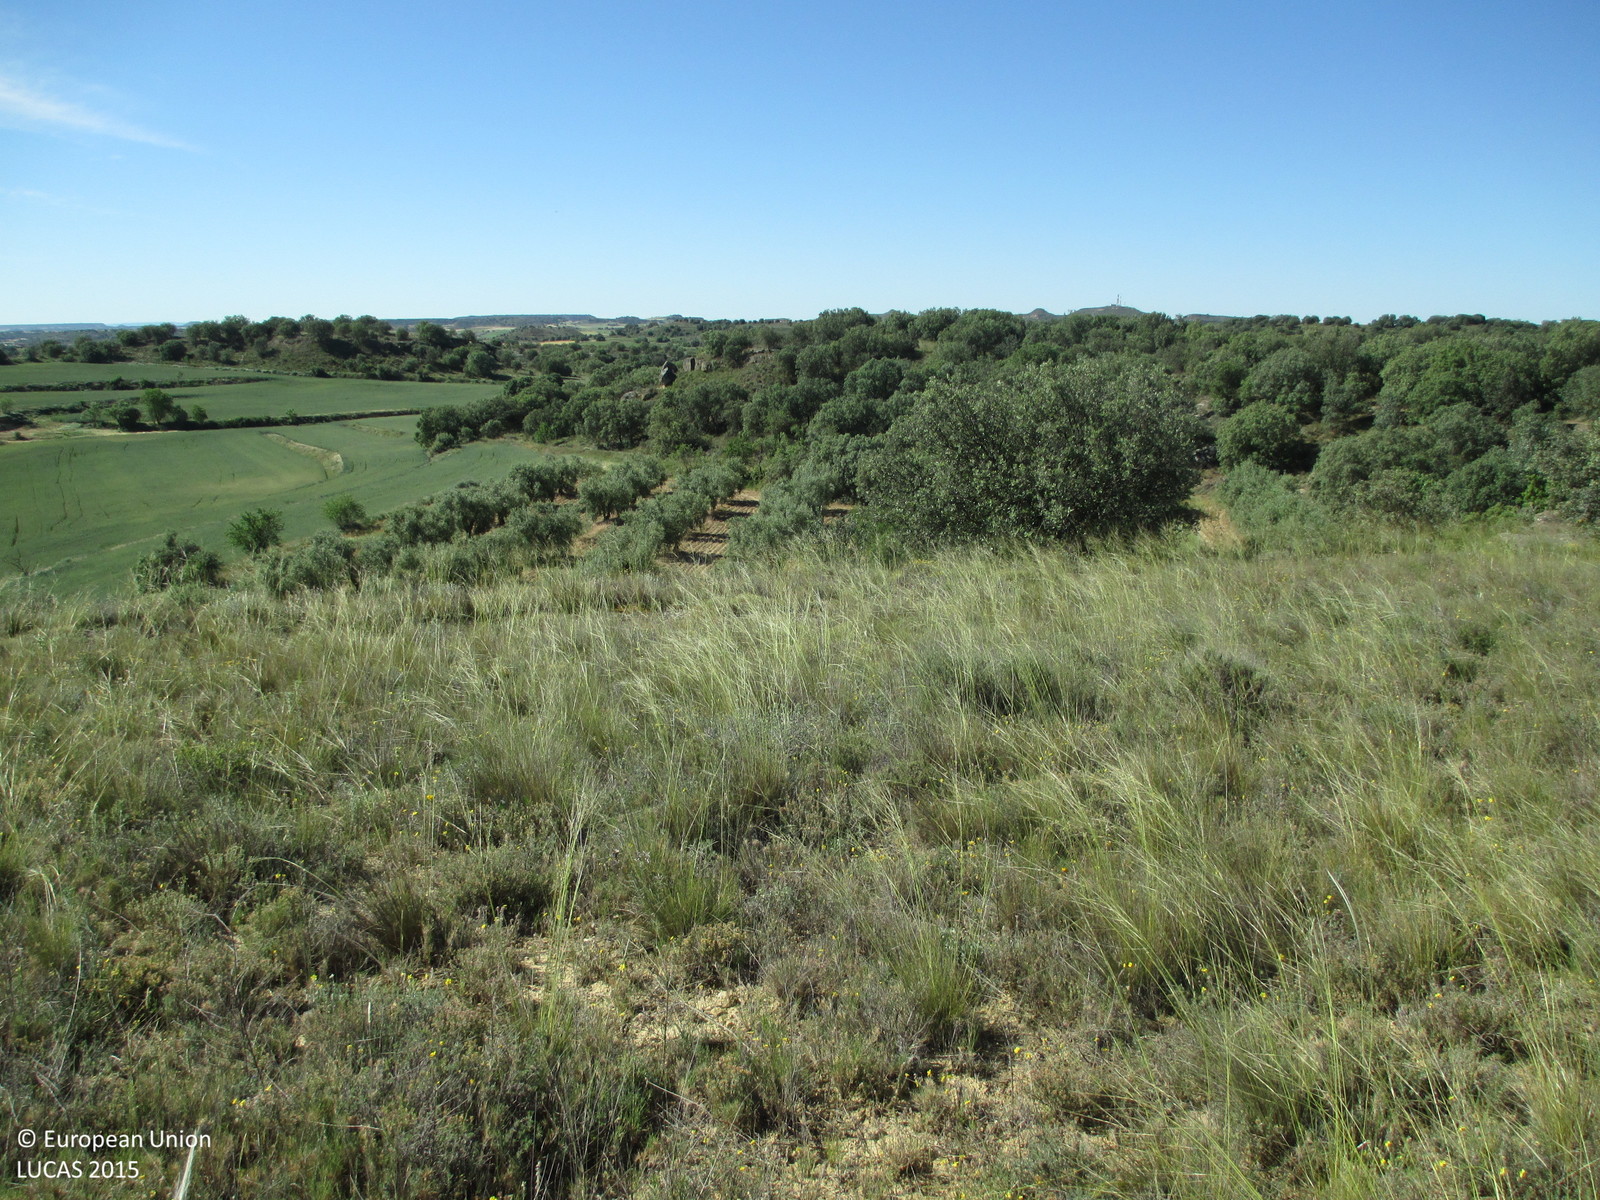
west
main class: Woodland
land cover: Broadleaved woodland
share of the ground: 25 - 50 %
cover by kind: herbaceous plants 50 %, broadleaved forest trees 40 %, shrubs 10 %
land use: Semi-natural and natural areas not in use
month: May
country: ES
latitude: 42.0544
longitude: -0.3038
